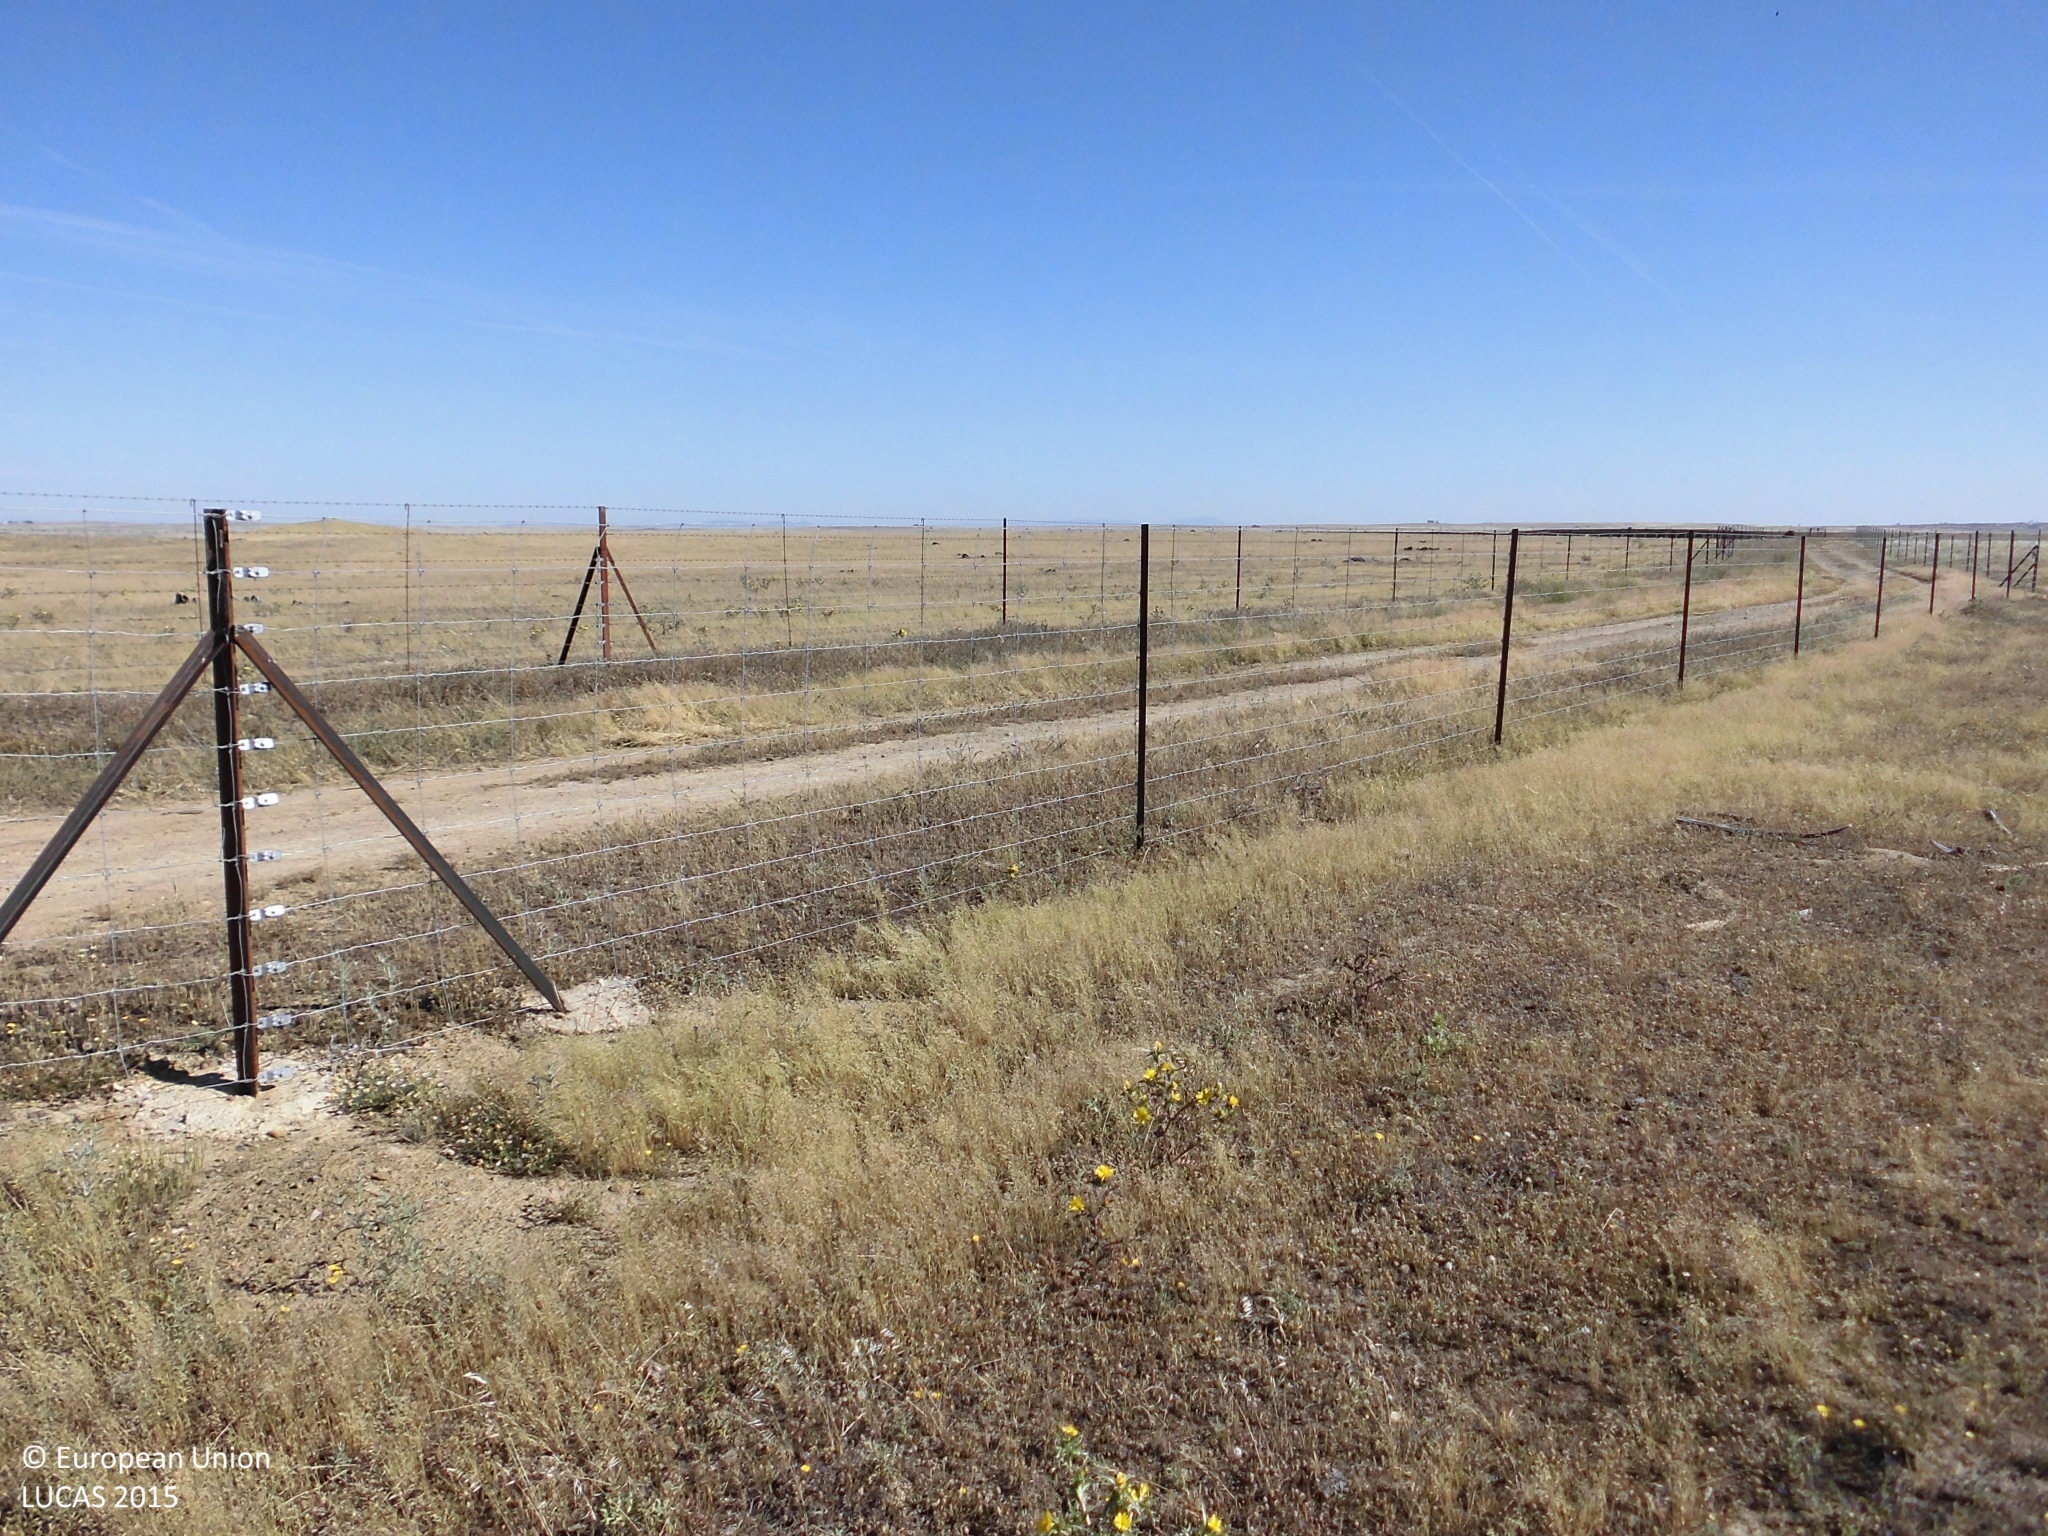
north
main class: Grassland
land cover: Grassland without tree/shrub cover
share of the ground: > 75 %
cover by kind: herbaceous plants 100 %
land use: Agriculture (excluding fallow land and kitchen gardens)
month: May
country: ES
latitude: 39.5364
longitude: -6.8450
